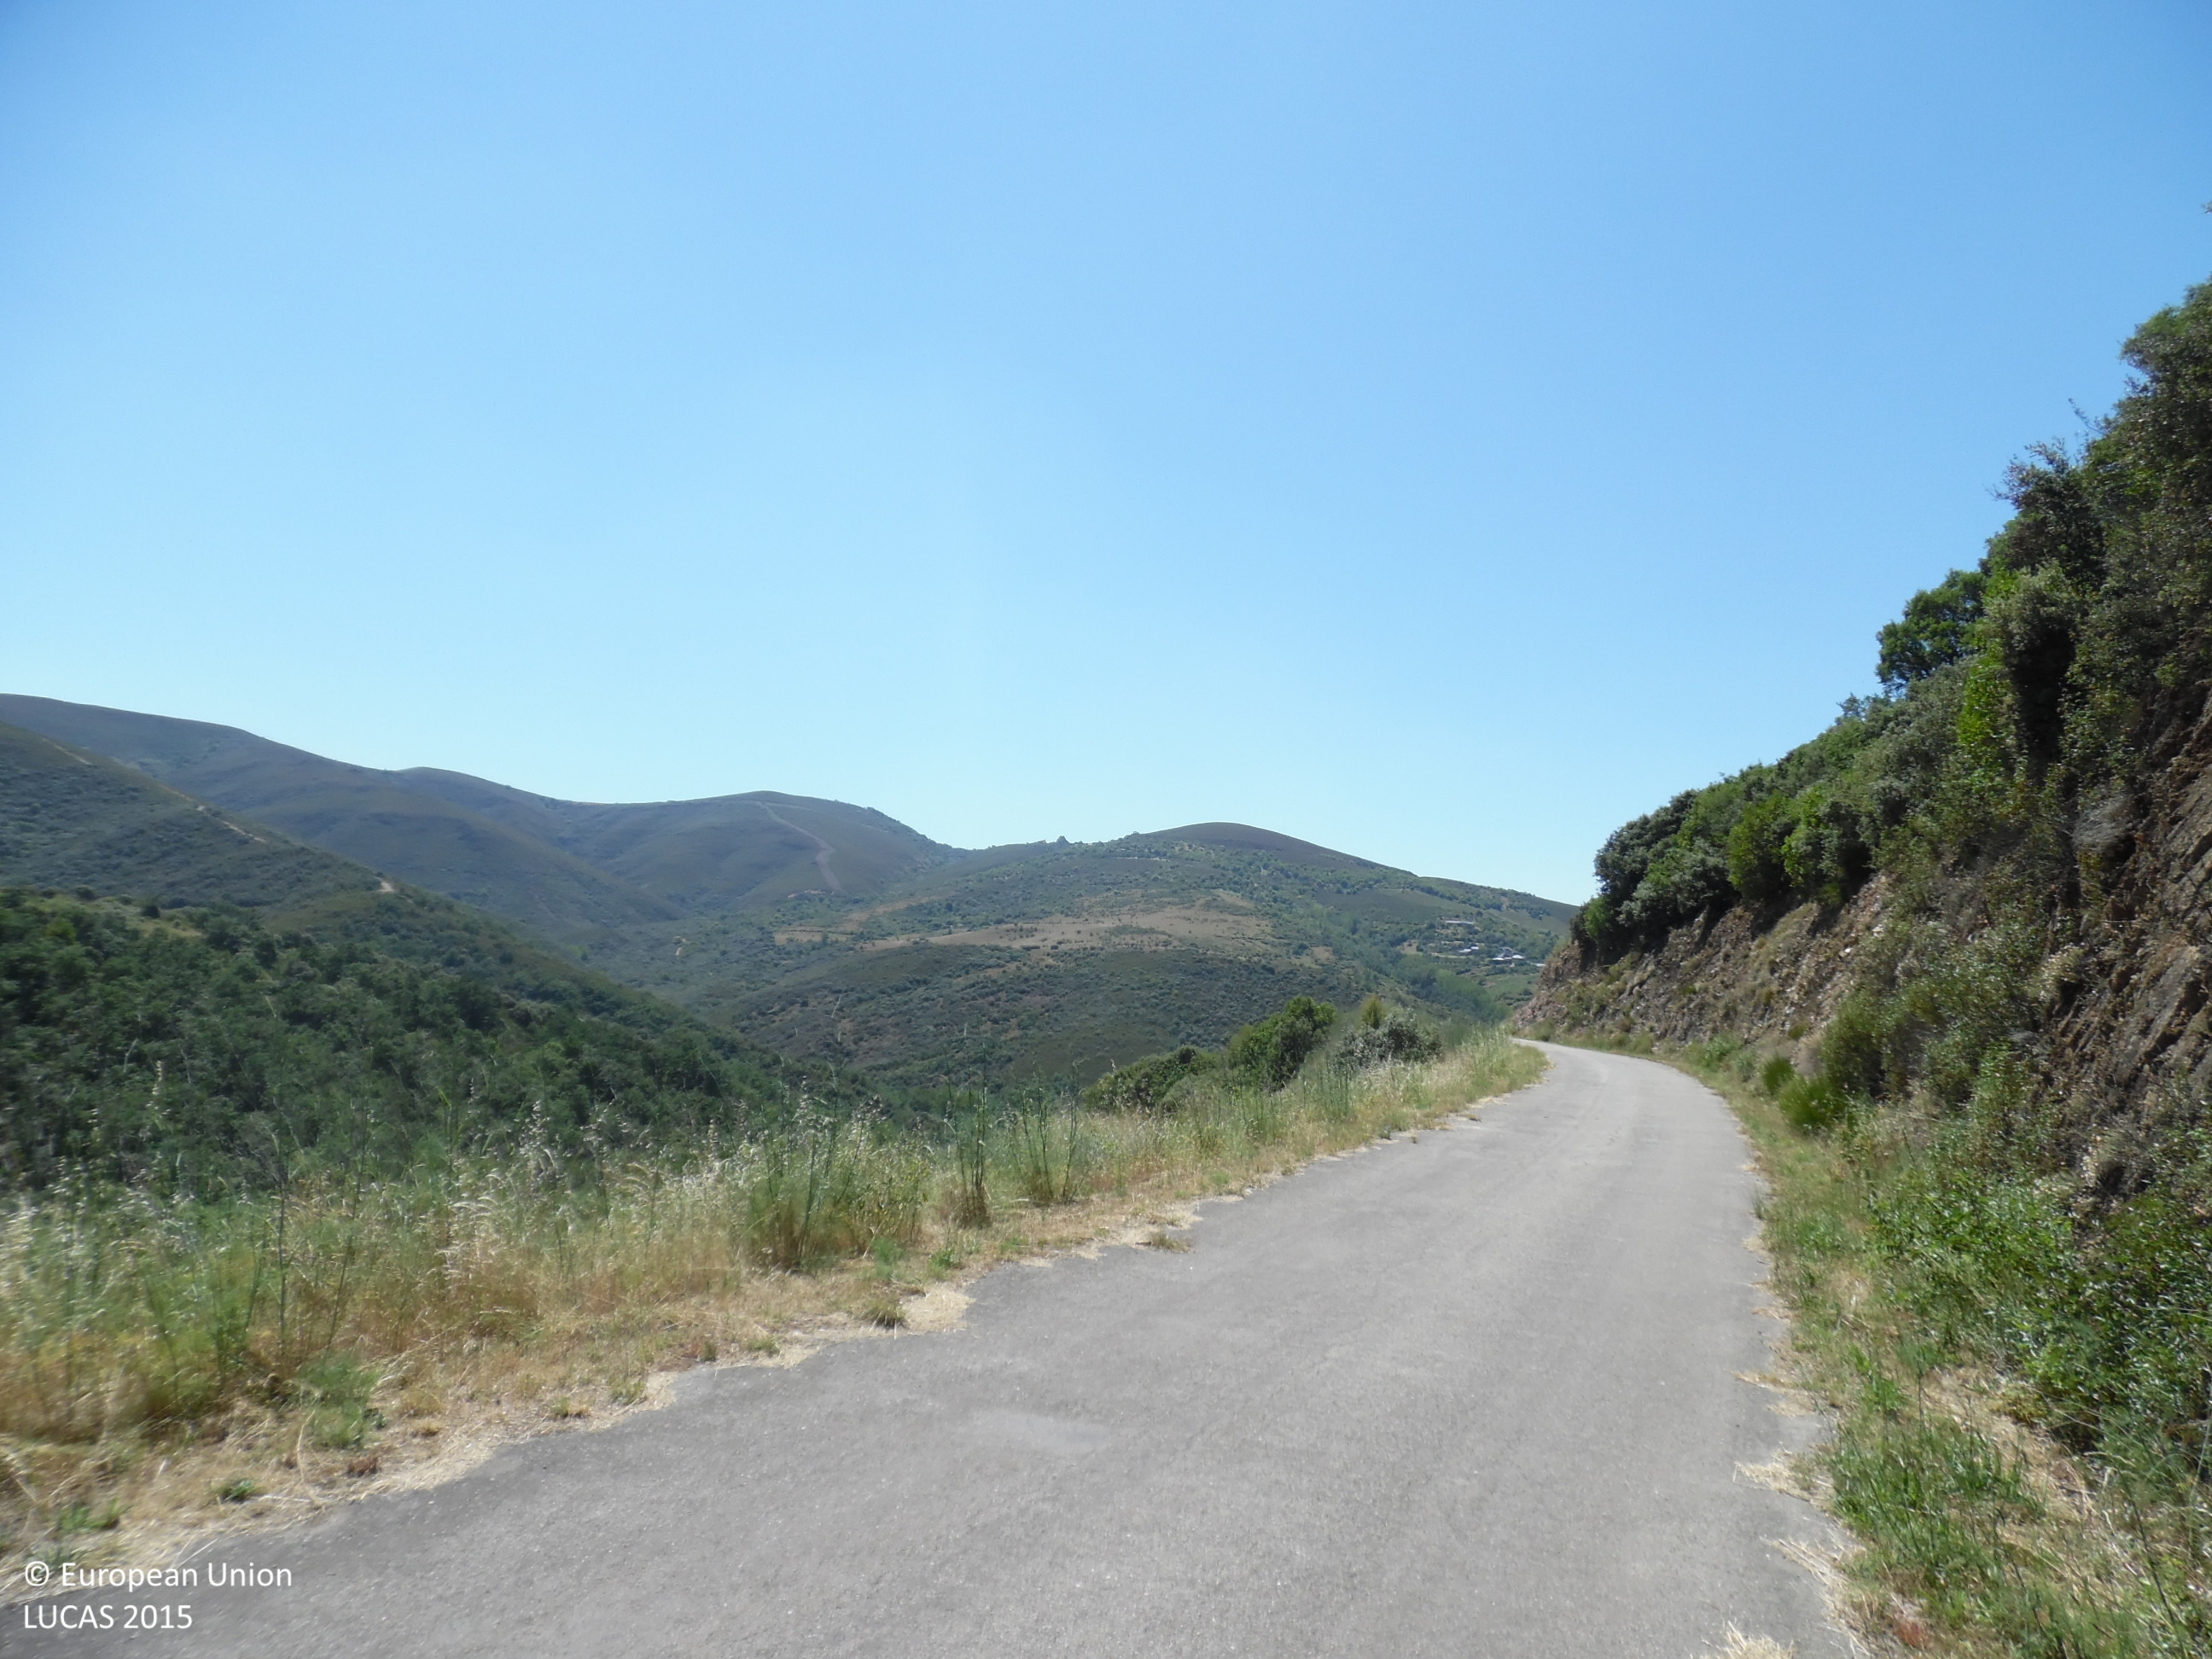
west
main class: Woodland
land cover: Broadleaved woodland
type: broadleaved evergreen forest
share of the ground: > 75 %
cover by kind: broadleaved forest trees 95 %, shrubs 5 %
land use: Forestry
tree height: > 5 m
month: June
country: ES
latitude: 42.4667
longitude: -6.7228
